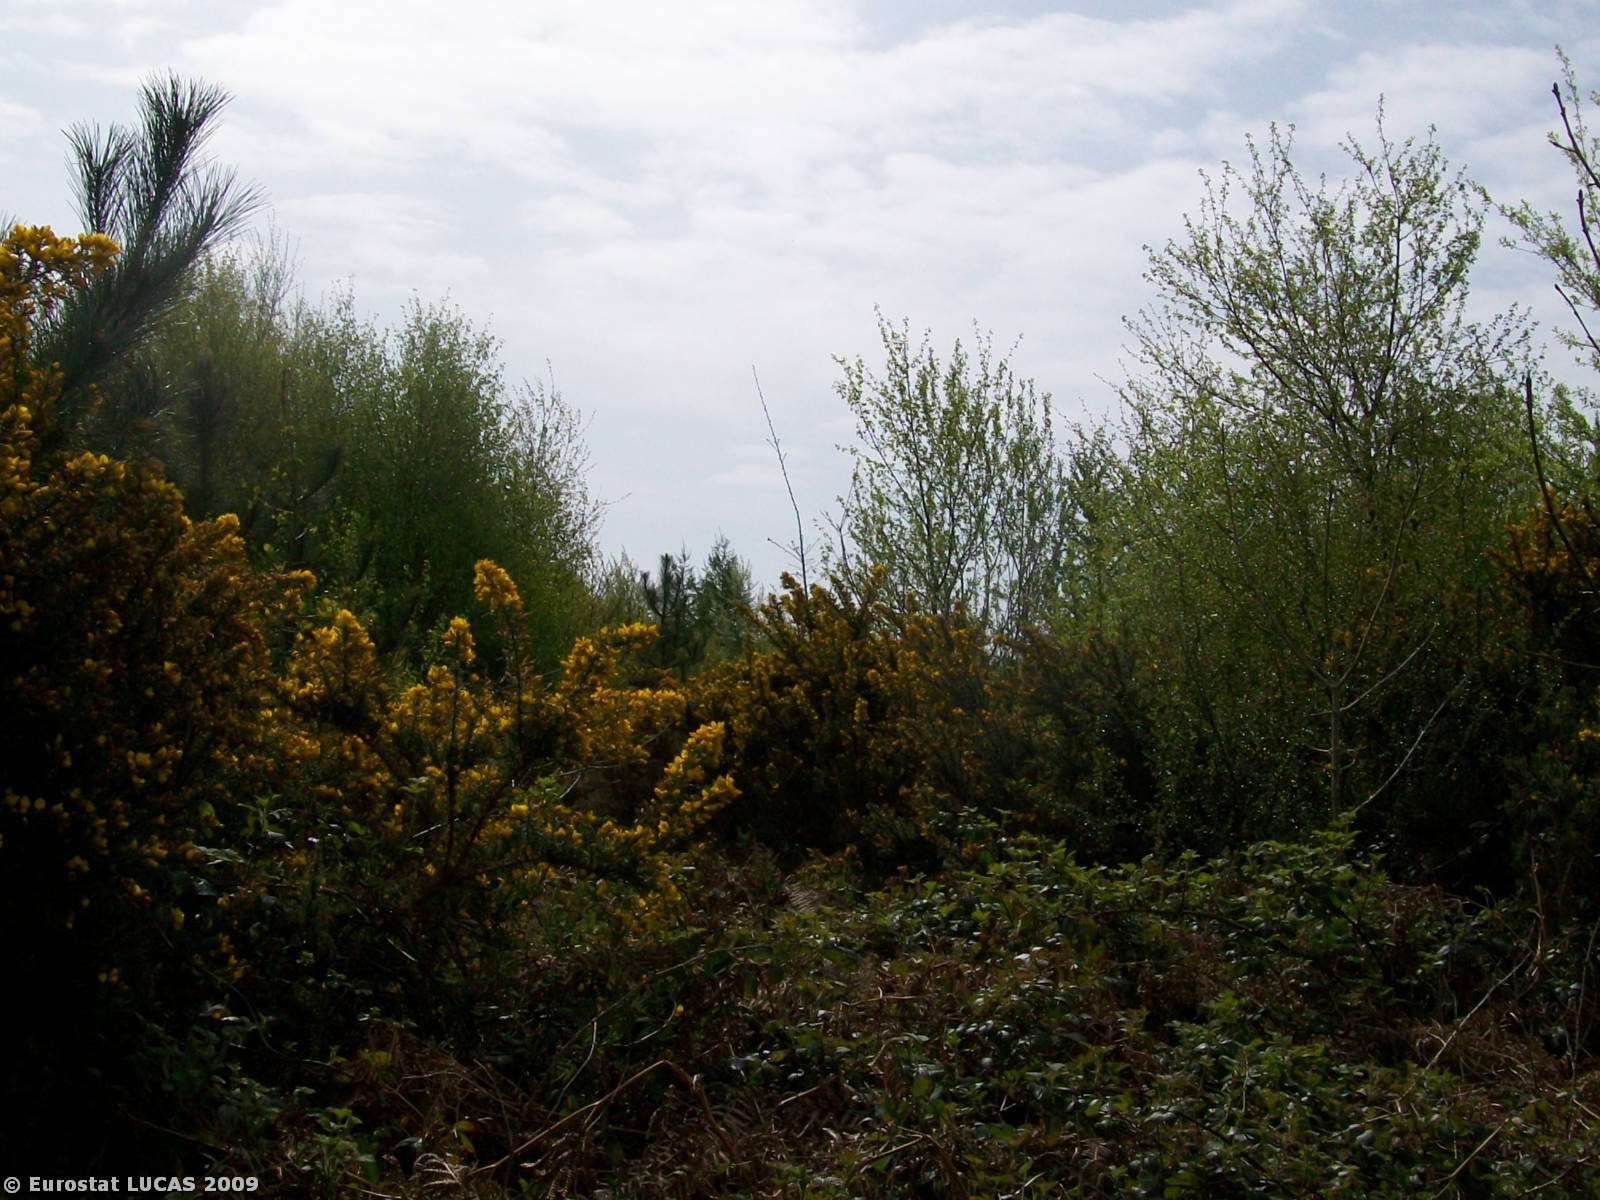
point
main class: Woodland
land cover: Mixed woodland
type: plantations and self-sown exotic forest
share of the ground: 50 - 75 %
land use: Amenities, museums, leisure
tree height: > 5 m
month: April
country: GB
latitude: 50.6336
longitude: -3.3570
